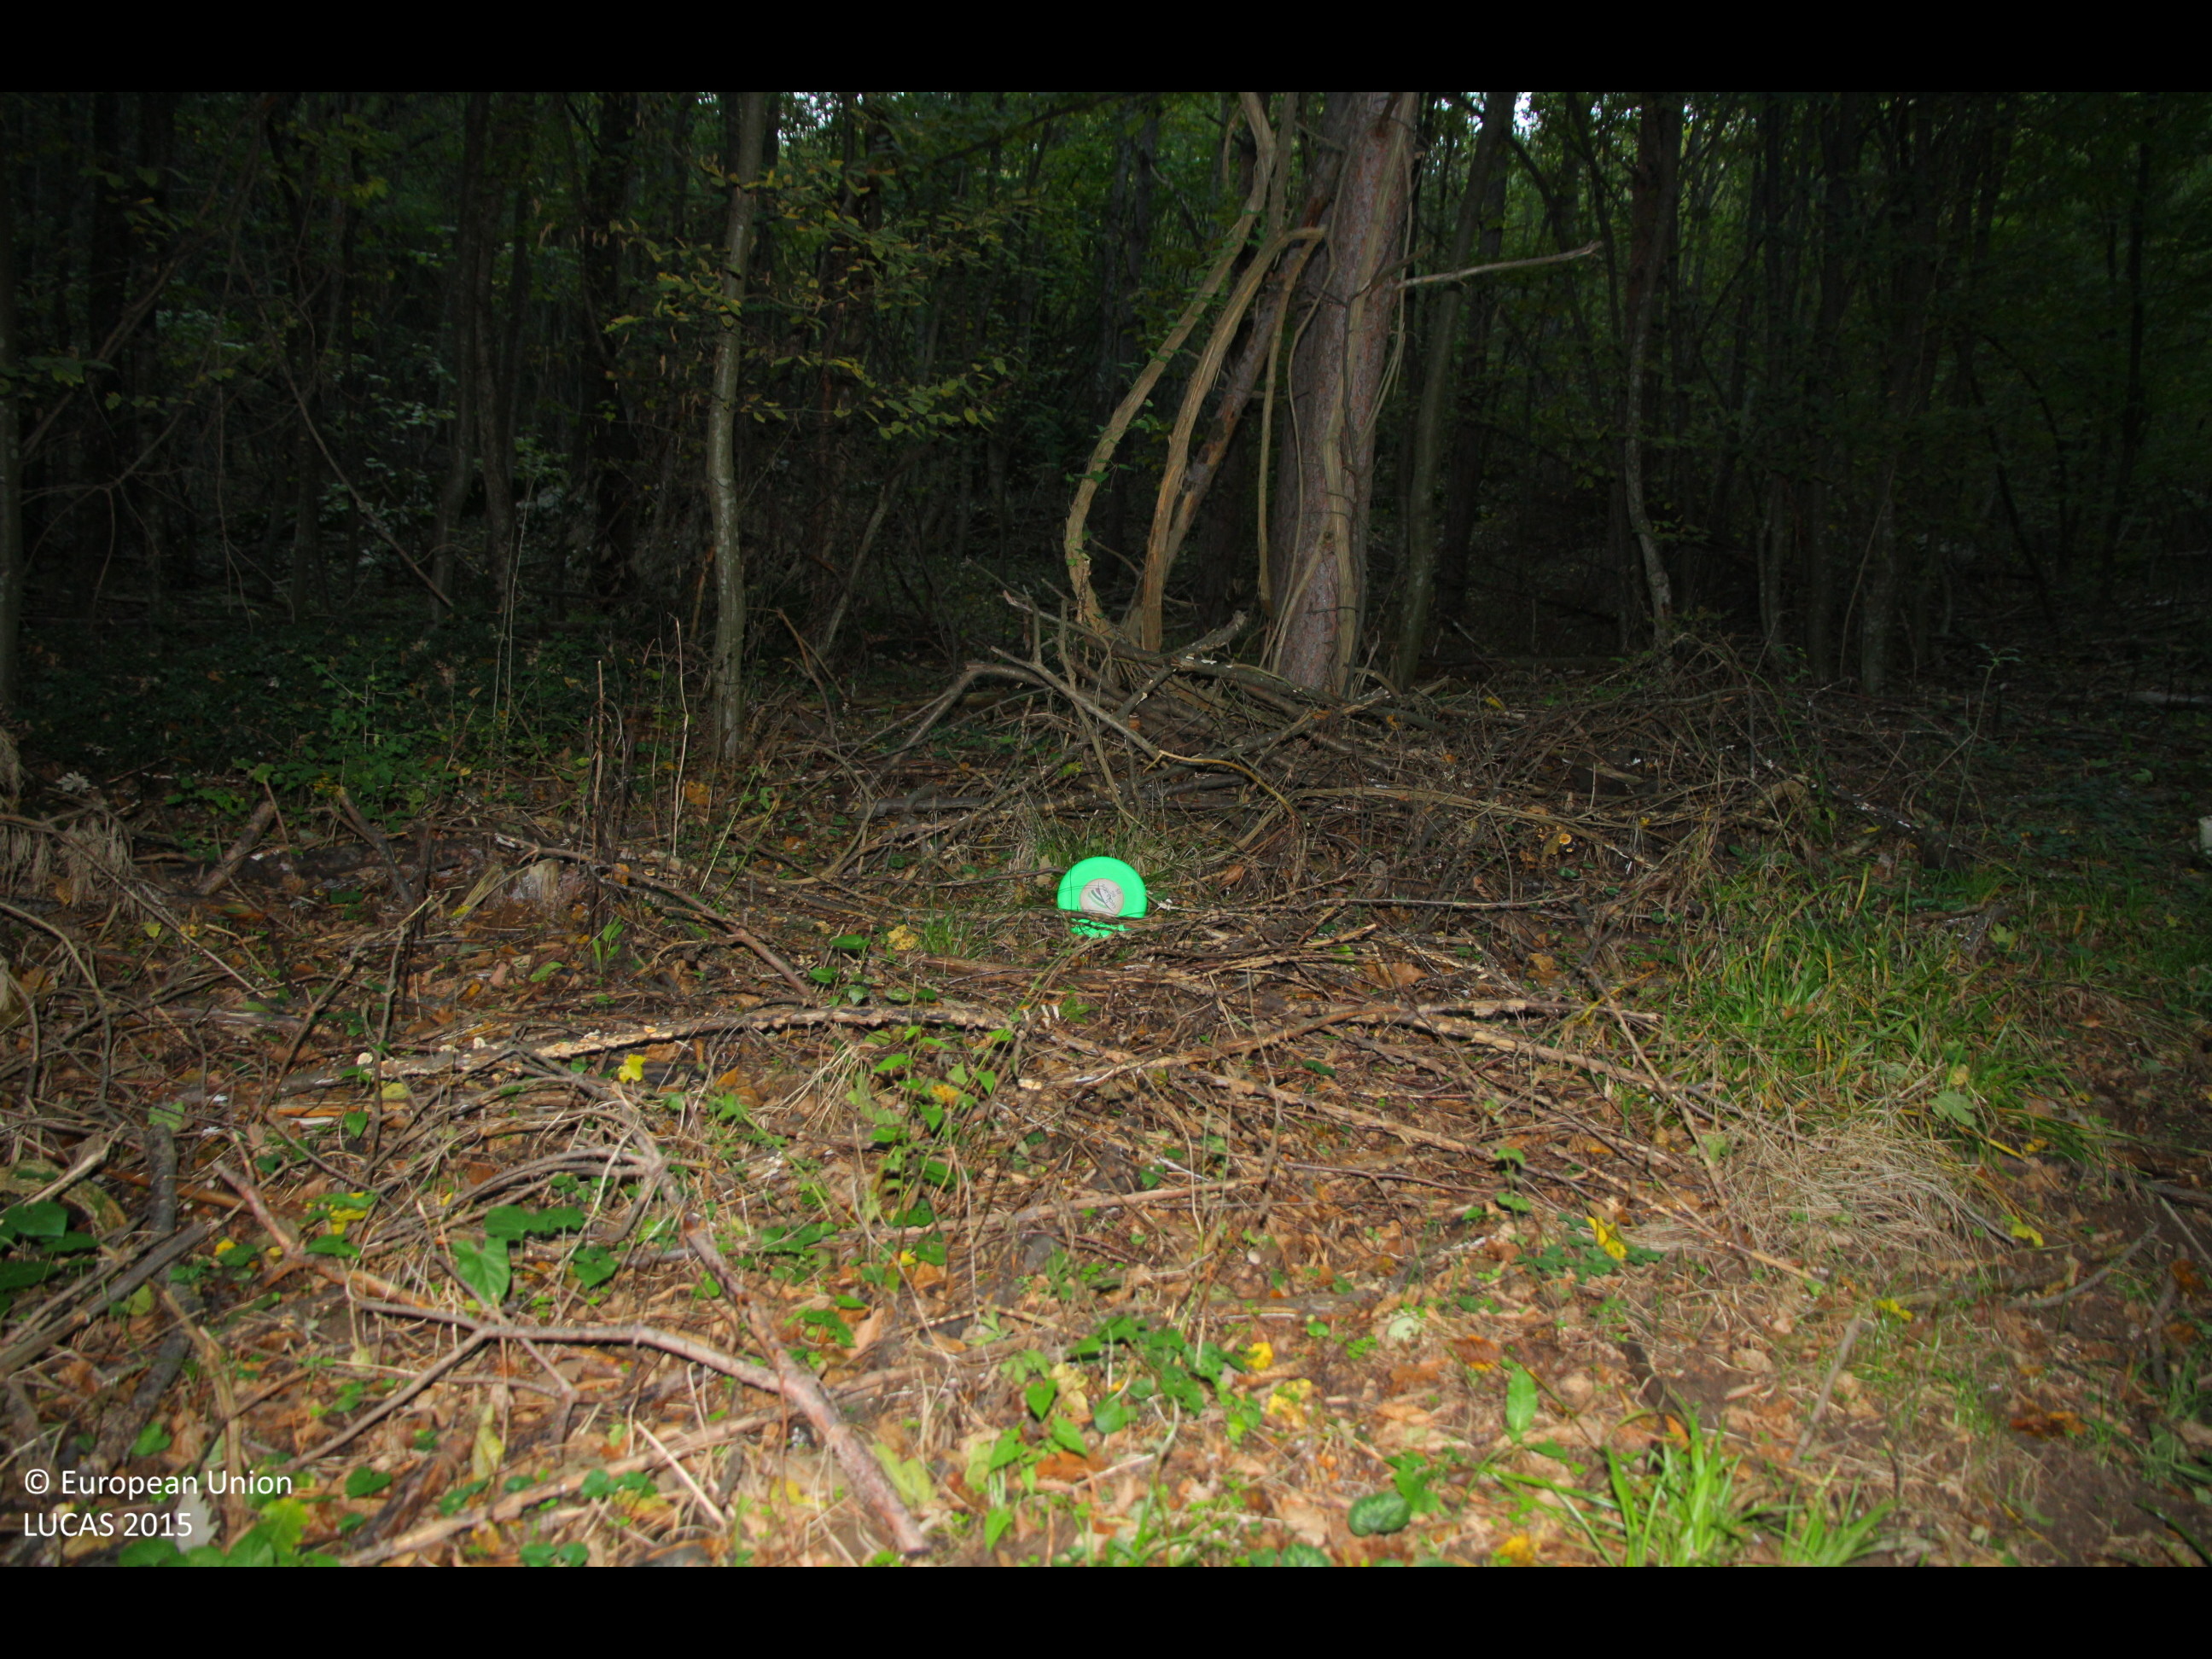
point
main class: Woodland
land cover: Other mixed woodland
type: acidophilous oak and oak-birch forest
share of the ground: > 75 %
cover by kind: broadleaved forest trees 75 %, coniferous forest trees 25 %
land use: Forestry
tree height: > 5 m
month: October
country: BG
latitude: 42.9513
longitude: 27.0134
